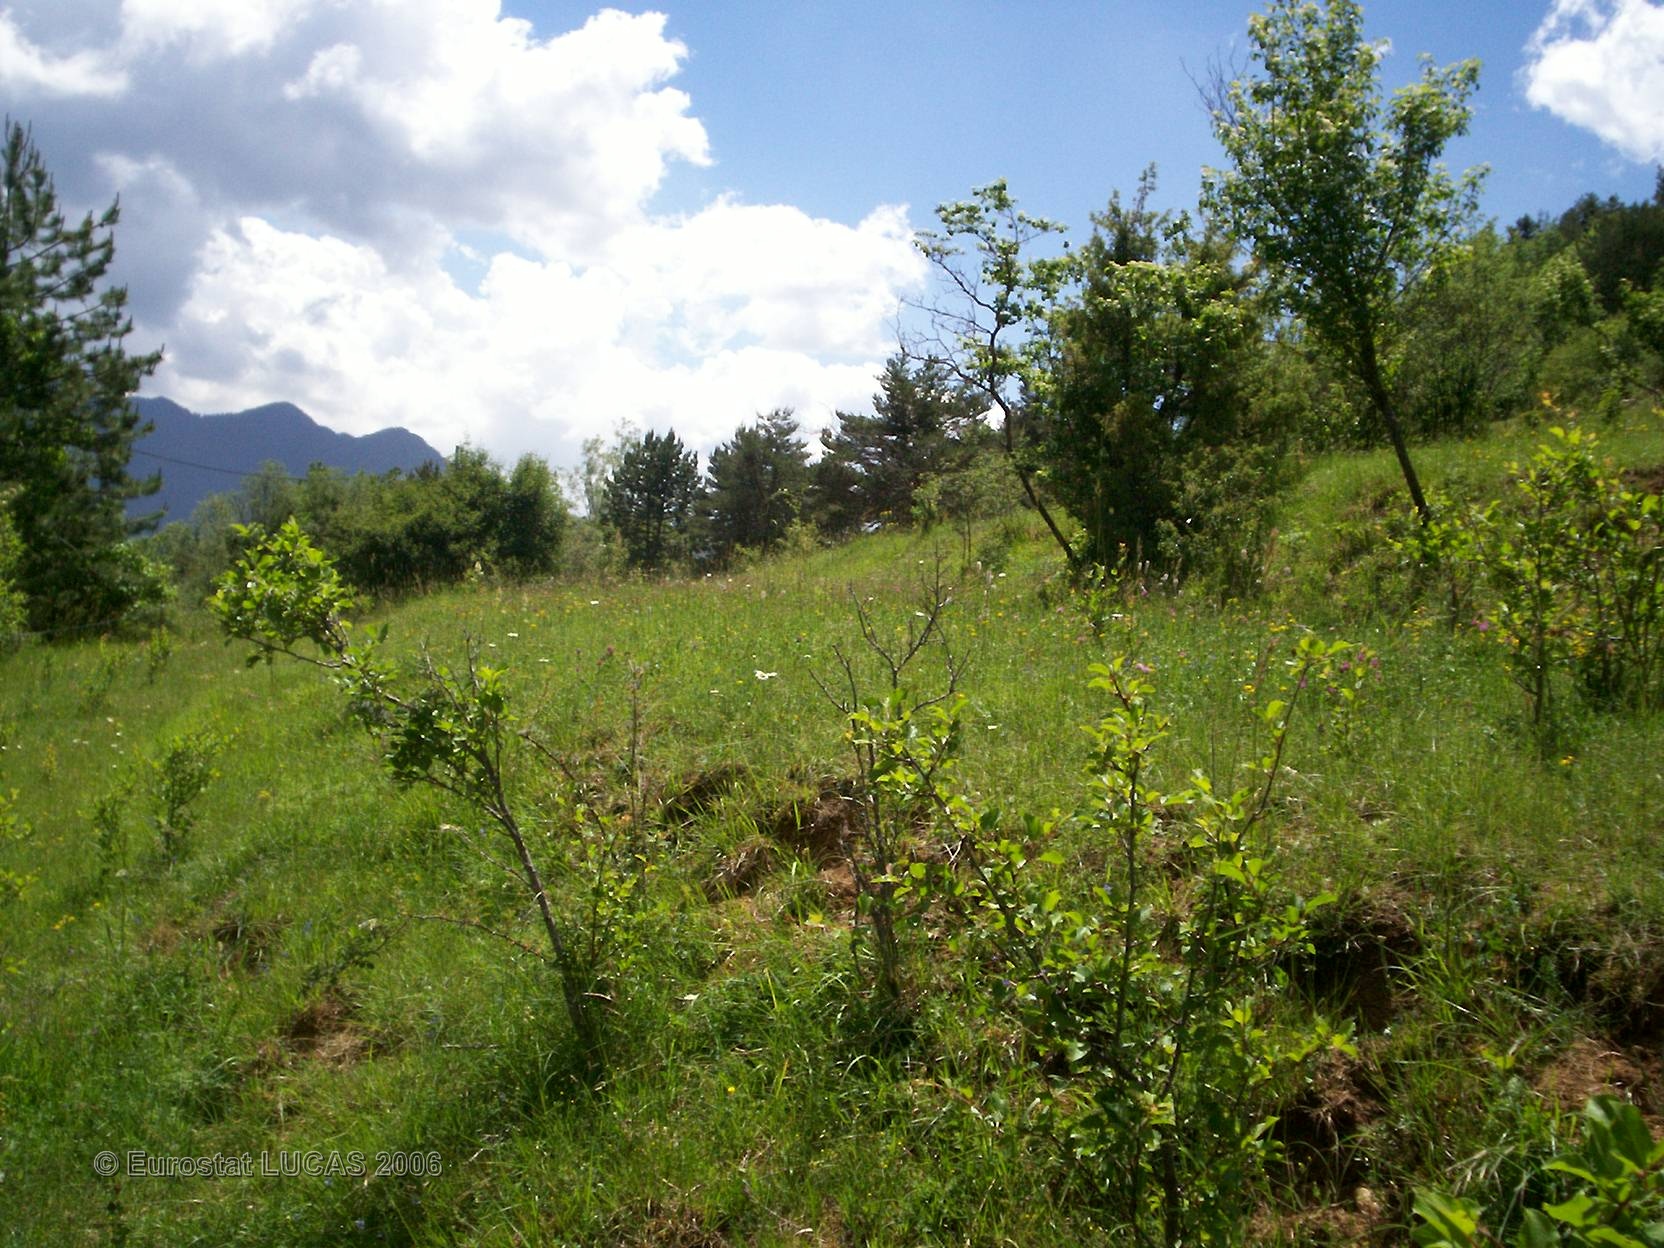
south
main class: Grassland
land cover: Grassland with sparse tree/shrub cover
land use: Agriculture (excluding fallow land and kitchen gardens)
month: May
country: FR
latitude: 44.0086
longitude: 7.2996
